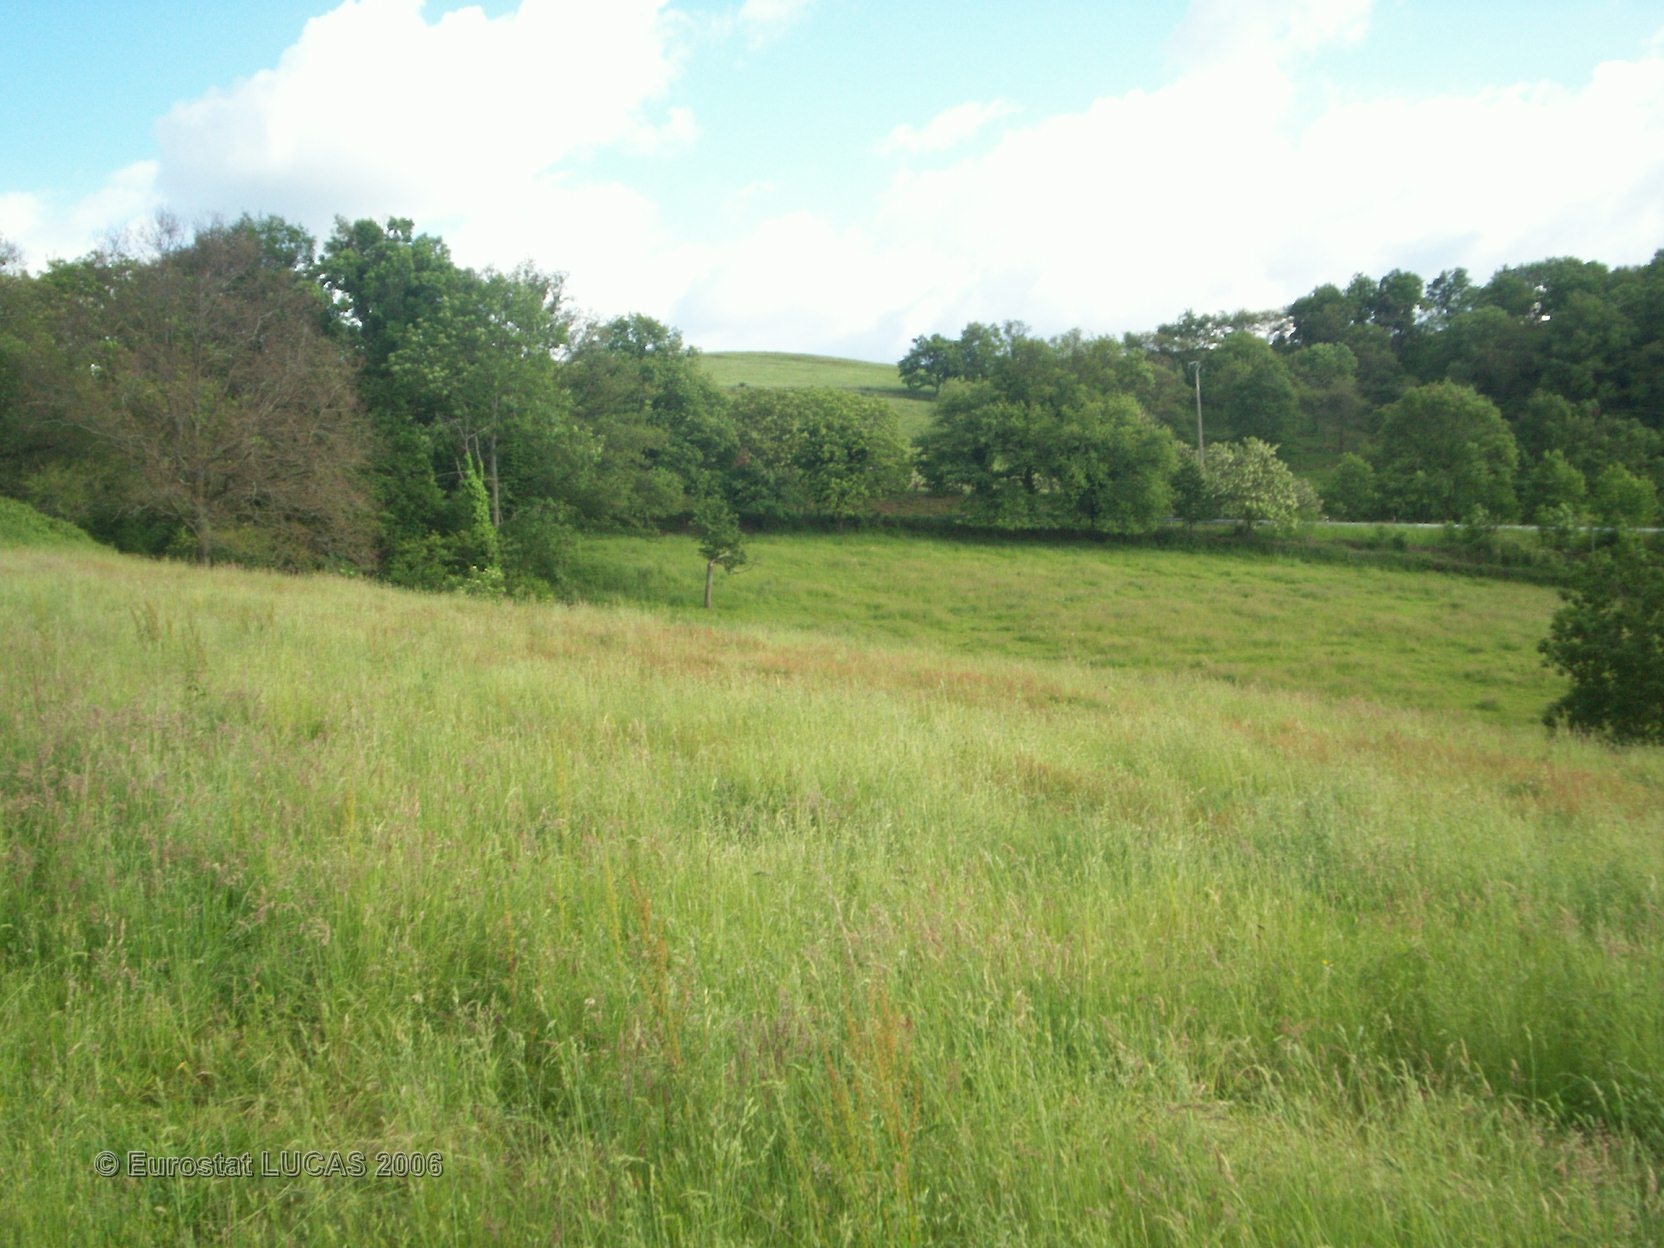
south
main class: Grassland
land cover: Grassland without tree/shrub cover
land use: Agriculture (excluding fallow land and kitchen gardens)
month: June
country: FR
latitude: 46.1121
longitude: 3.1284
